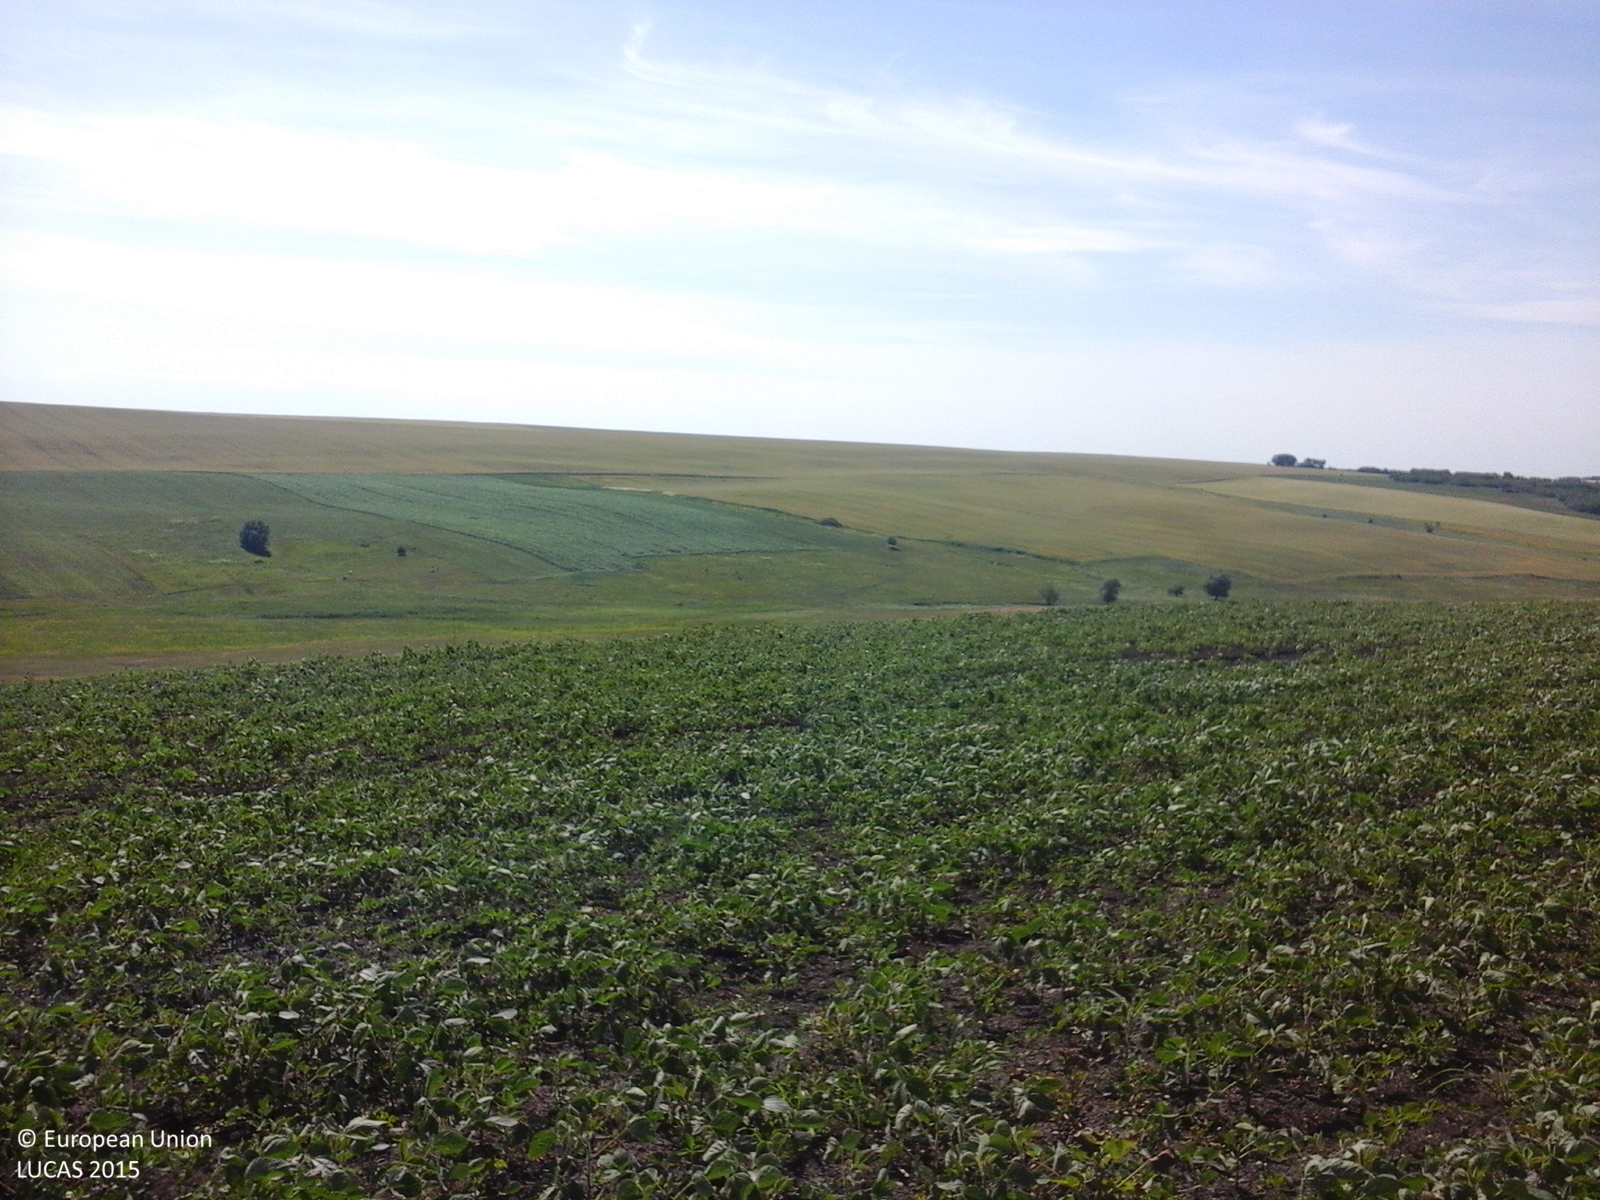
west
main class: Cropland
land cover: Soya
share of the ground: > 75 %
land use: Agriculture (excluding fallow land and kitchen gardens)
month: June
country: RO
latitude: 48.2162
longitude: 26.7489
